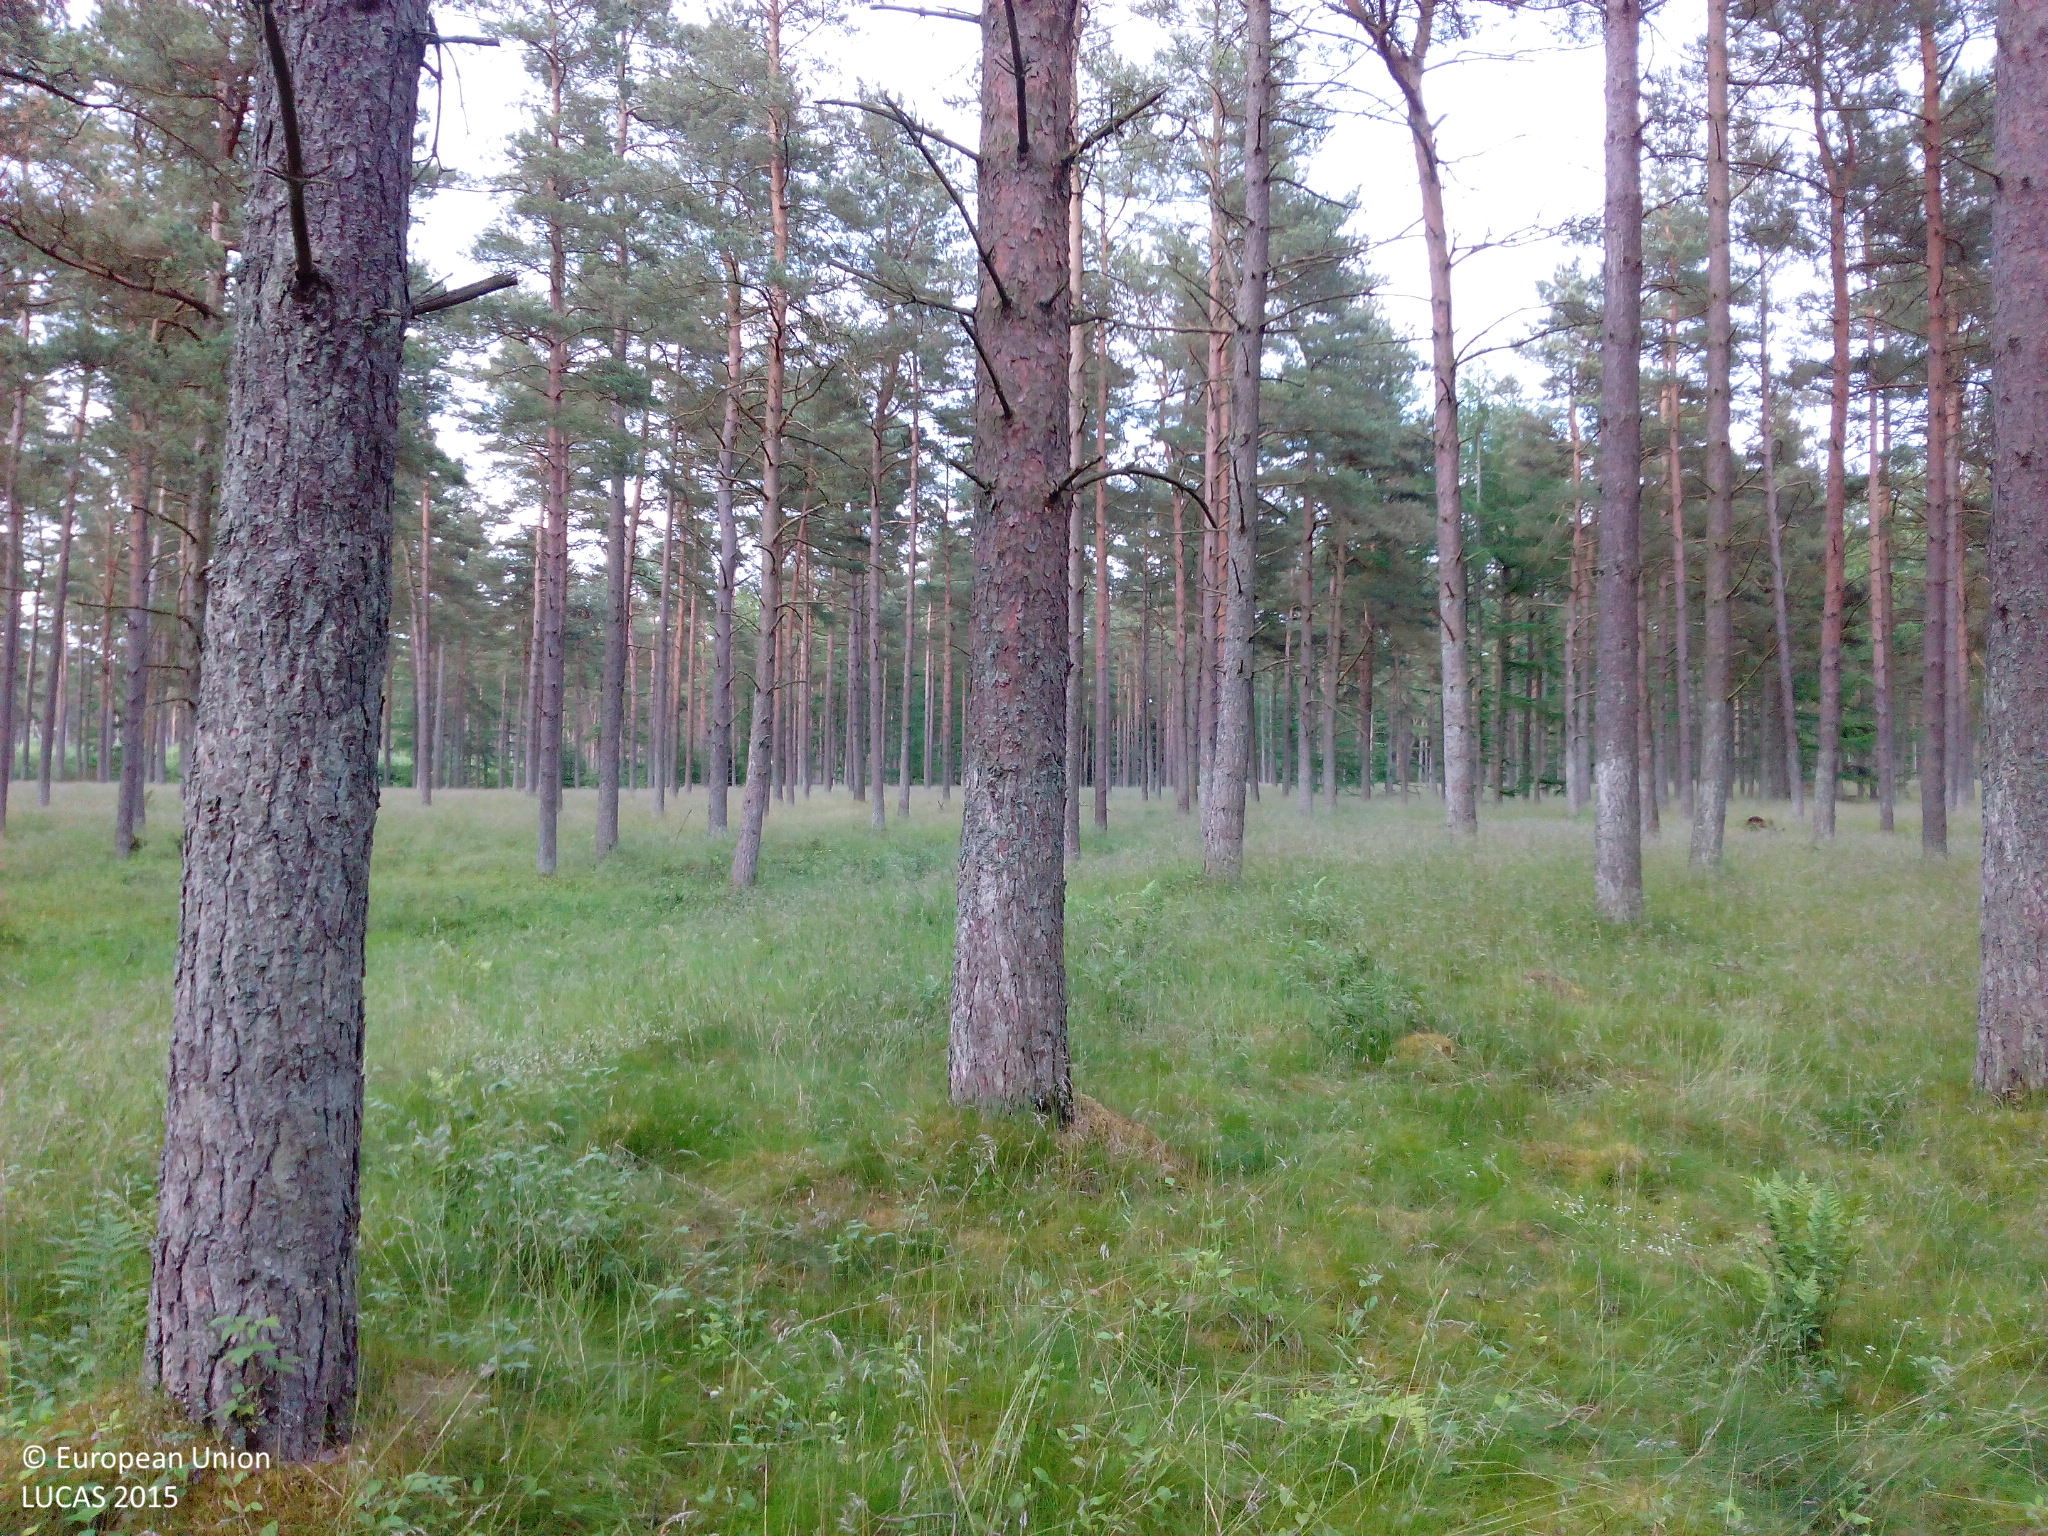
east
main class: Woodland
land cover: Pine dominated coniferous woodland
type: hemiboreal forest and nemoral coniferous forest and mixed broadleaved-coniferous forest
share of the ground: 25 - 50 %
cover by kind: herbaceous plants 50 %, coniferous forest trees 30 %, lichens and mosses 20 %
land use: Forestry
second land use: Amenities, museums, leisure
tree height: > 5 m
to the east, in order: Pine dominated coniferous woodland; Other coniferous woodland
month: June
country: DK
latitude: 56.2939
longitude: 10.6616
